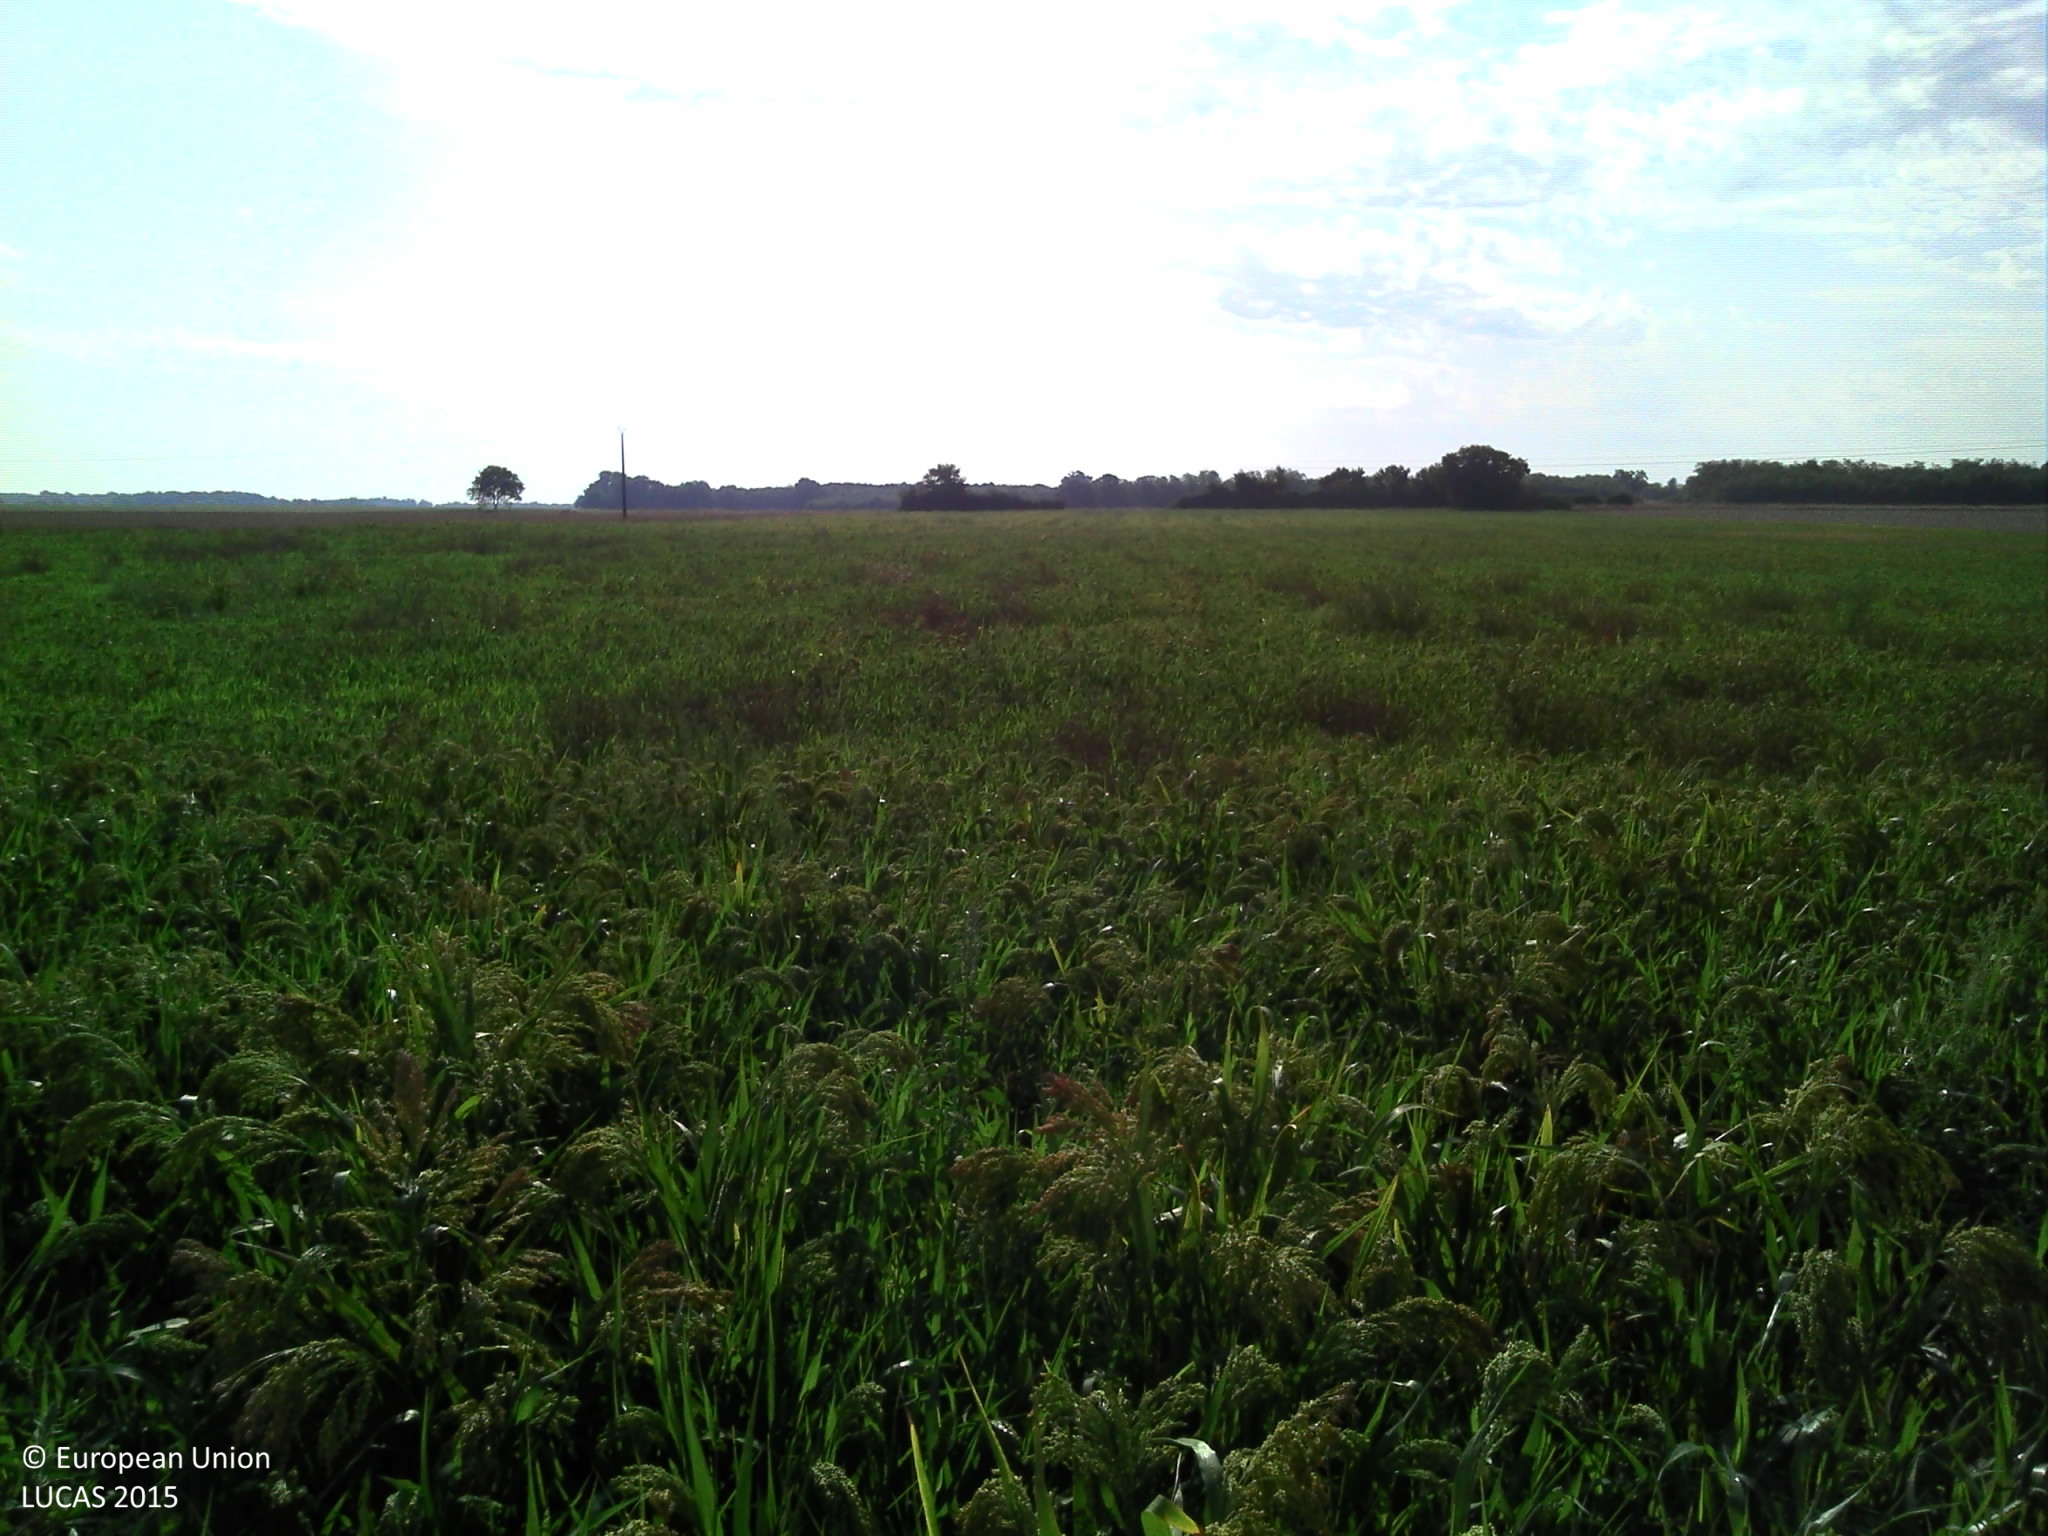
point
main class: Cropland
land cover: Other cereals
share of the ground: > 75 %
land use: Agriculture (excluding fallow land and kitchen gardens)
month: August
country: FR
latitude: 46.1819
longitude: 0.3050
